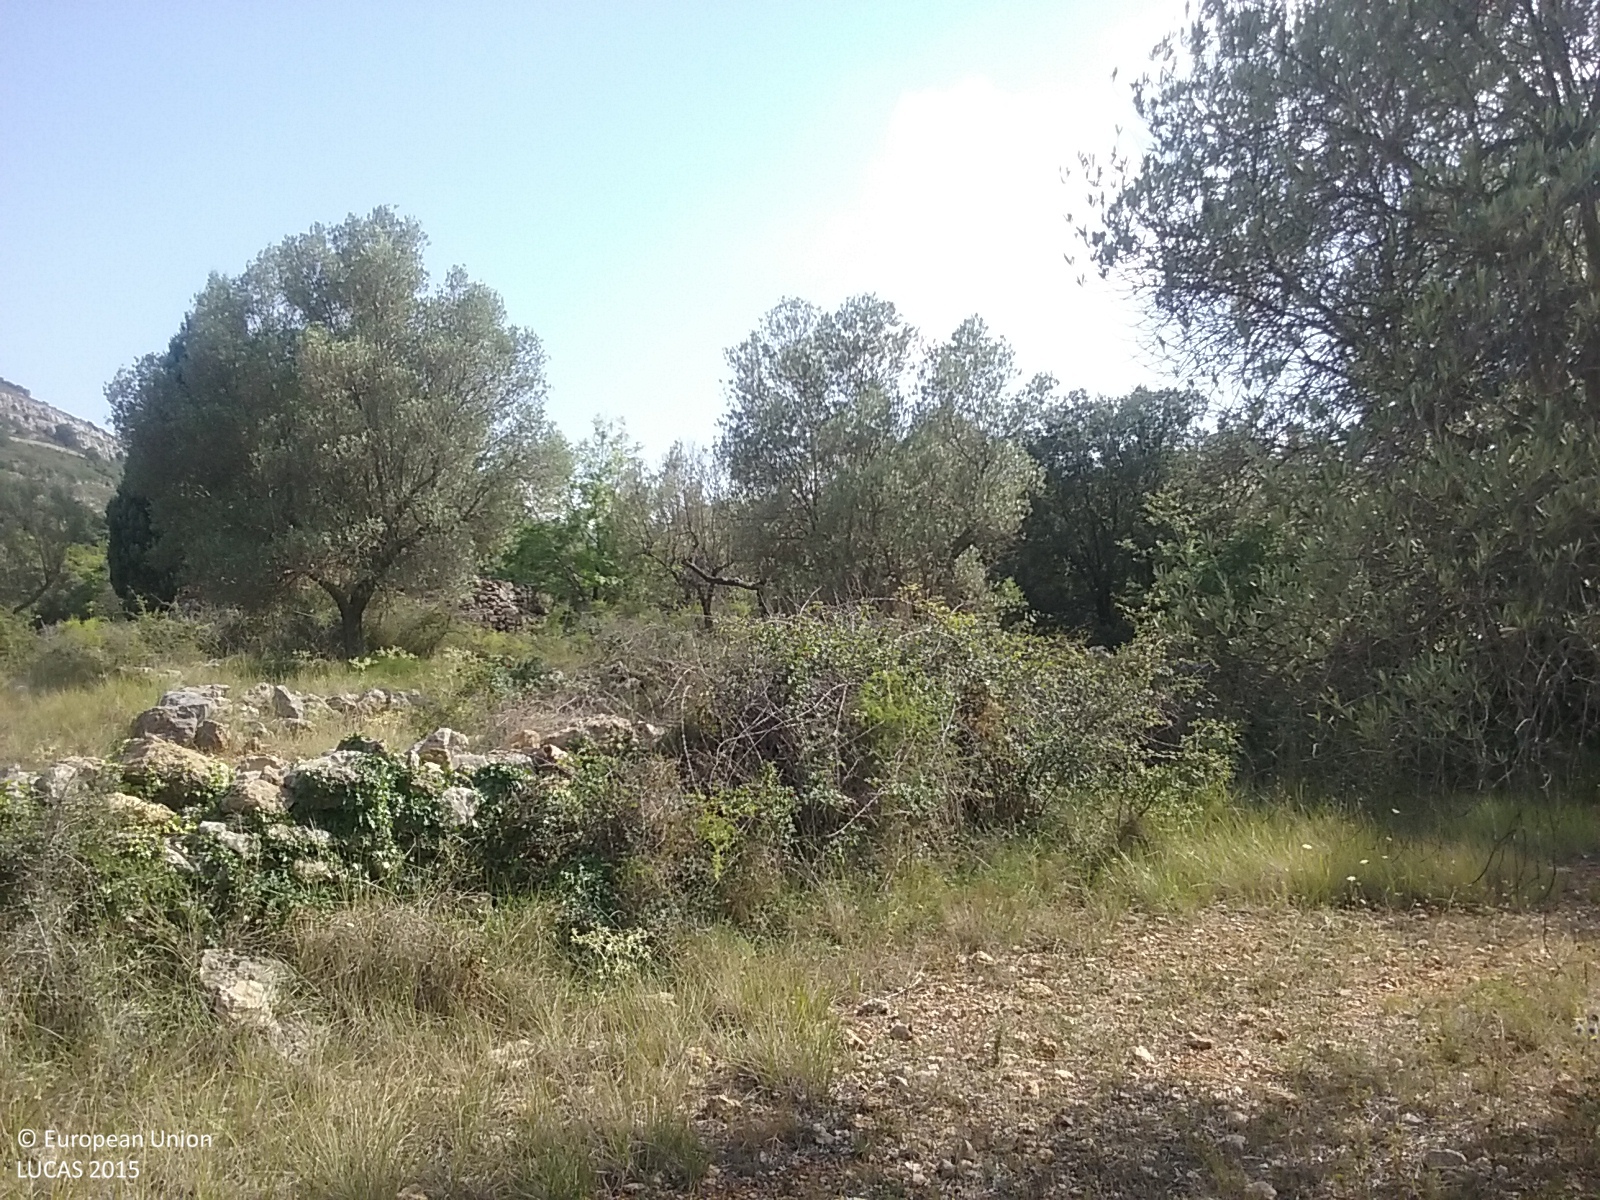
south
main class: Cropland
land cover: Olive groves
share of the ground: 25 - 50 %
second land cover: Spontaneously vegetated surfaces
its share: 25 - 50 %
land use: Agriculture (excluding fallow land and kitchen gardens)
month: August
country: ES
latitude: 40.3383
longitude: 0.0018
